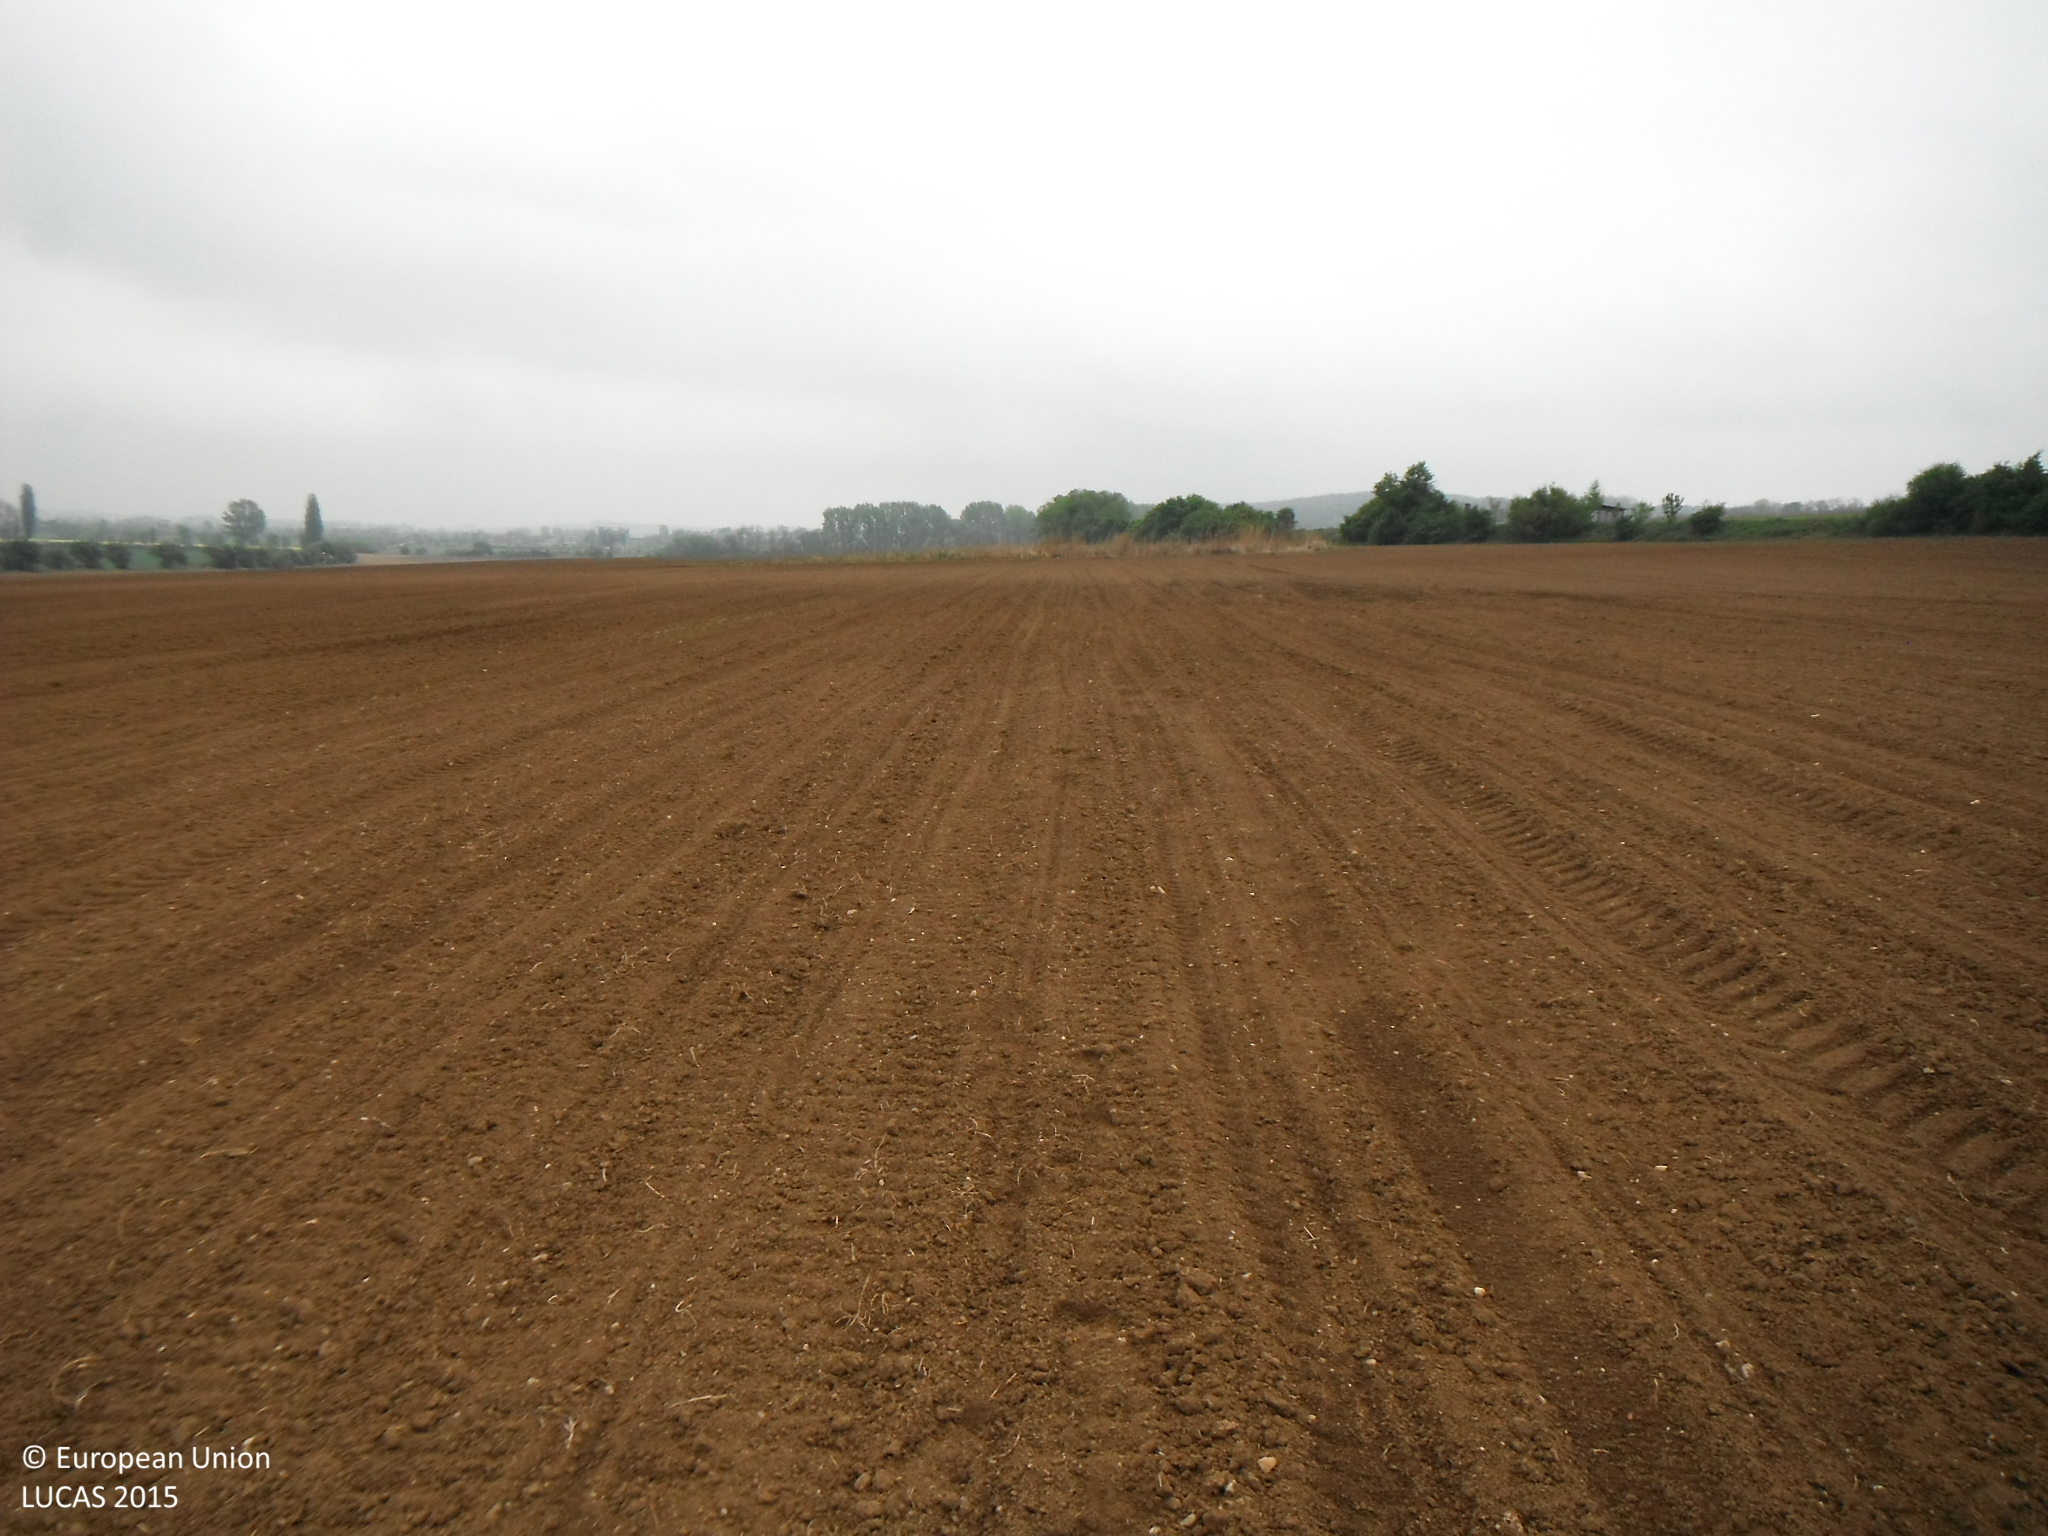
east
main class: Cropland
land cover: Maize
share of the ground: < 10 %
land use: Agriculture (excluding fallow land and kitchen gardens)
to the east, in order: Maize; Spontaneously vegetated surfaces; Maize
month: May
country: SK
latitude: 48.5295
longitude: 21.1329
